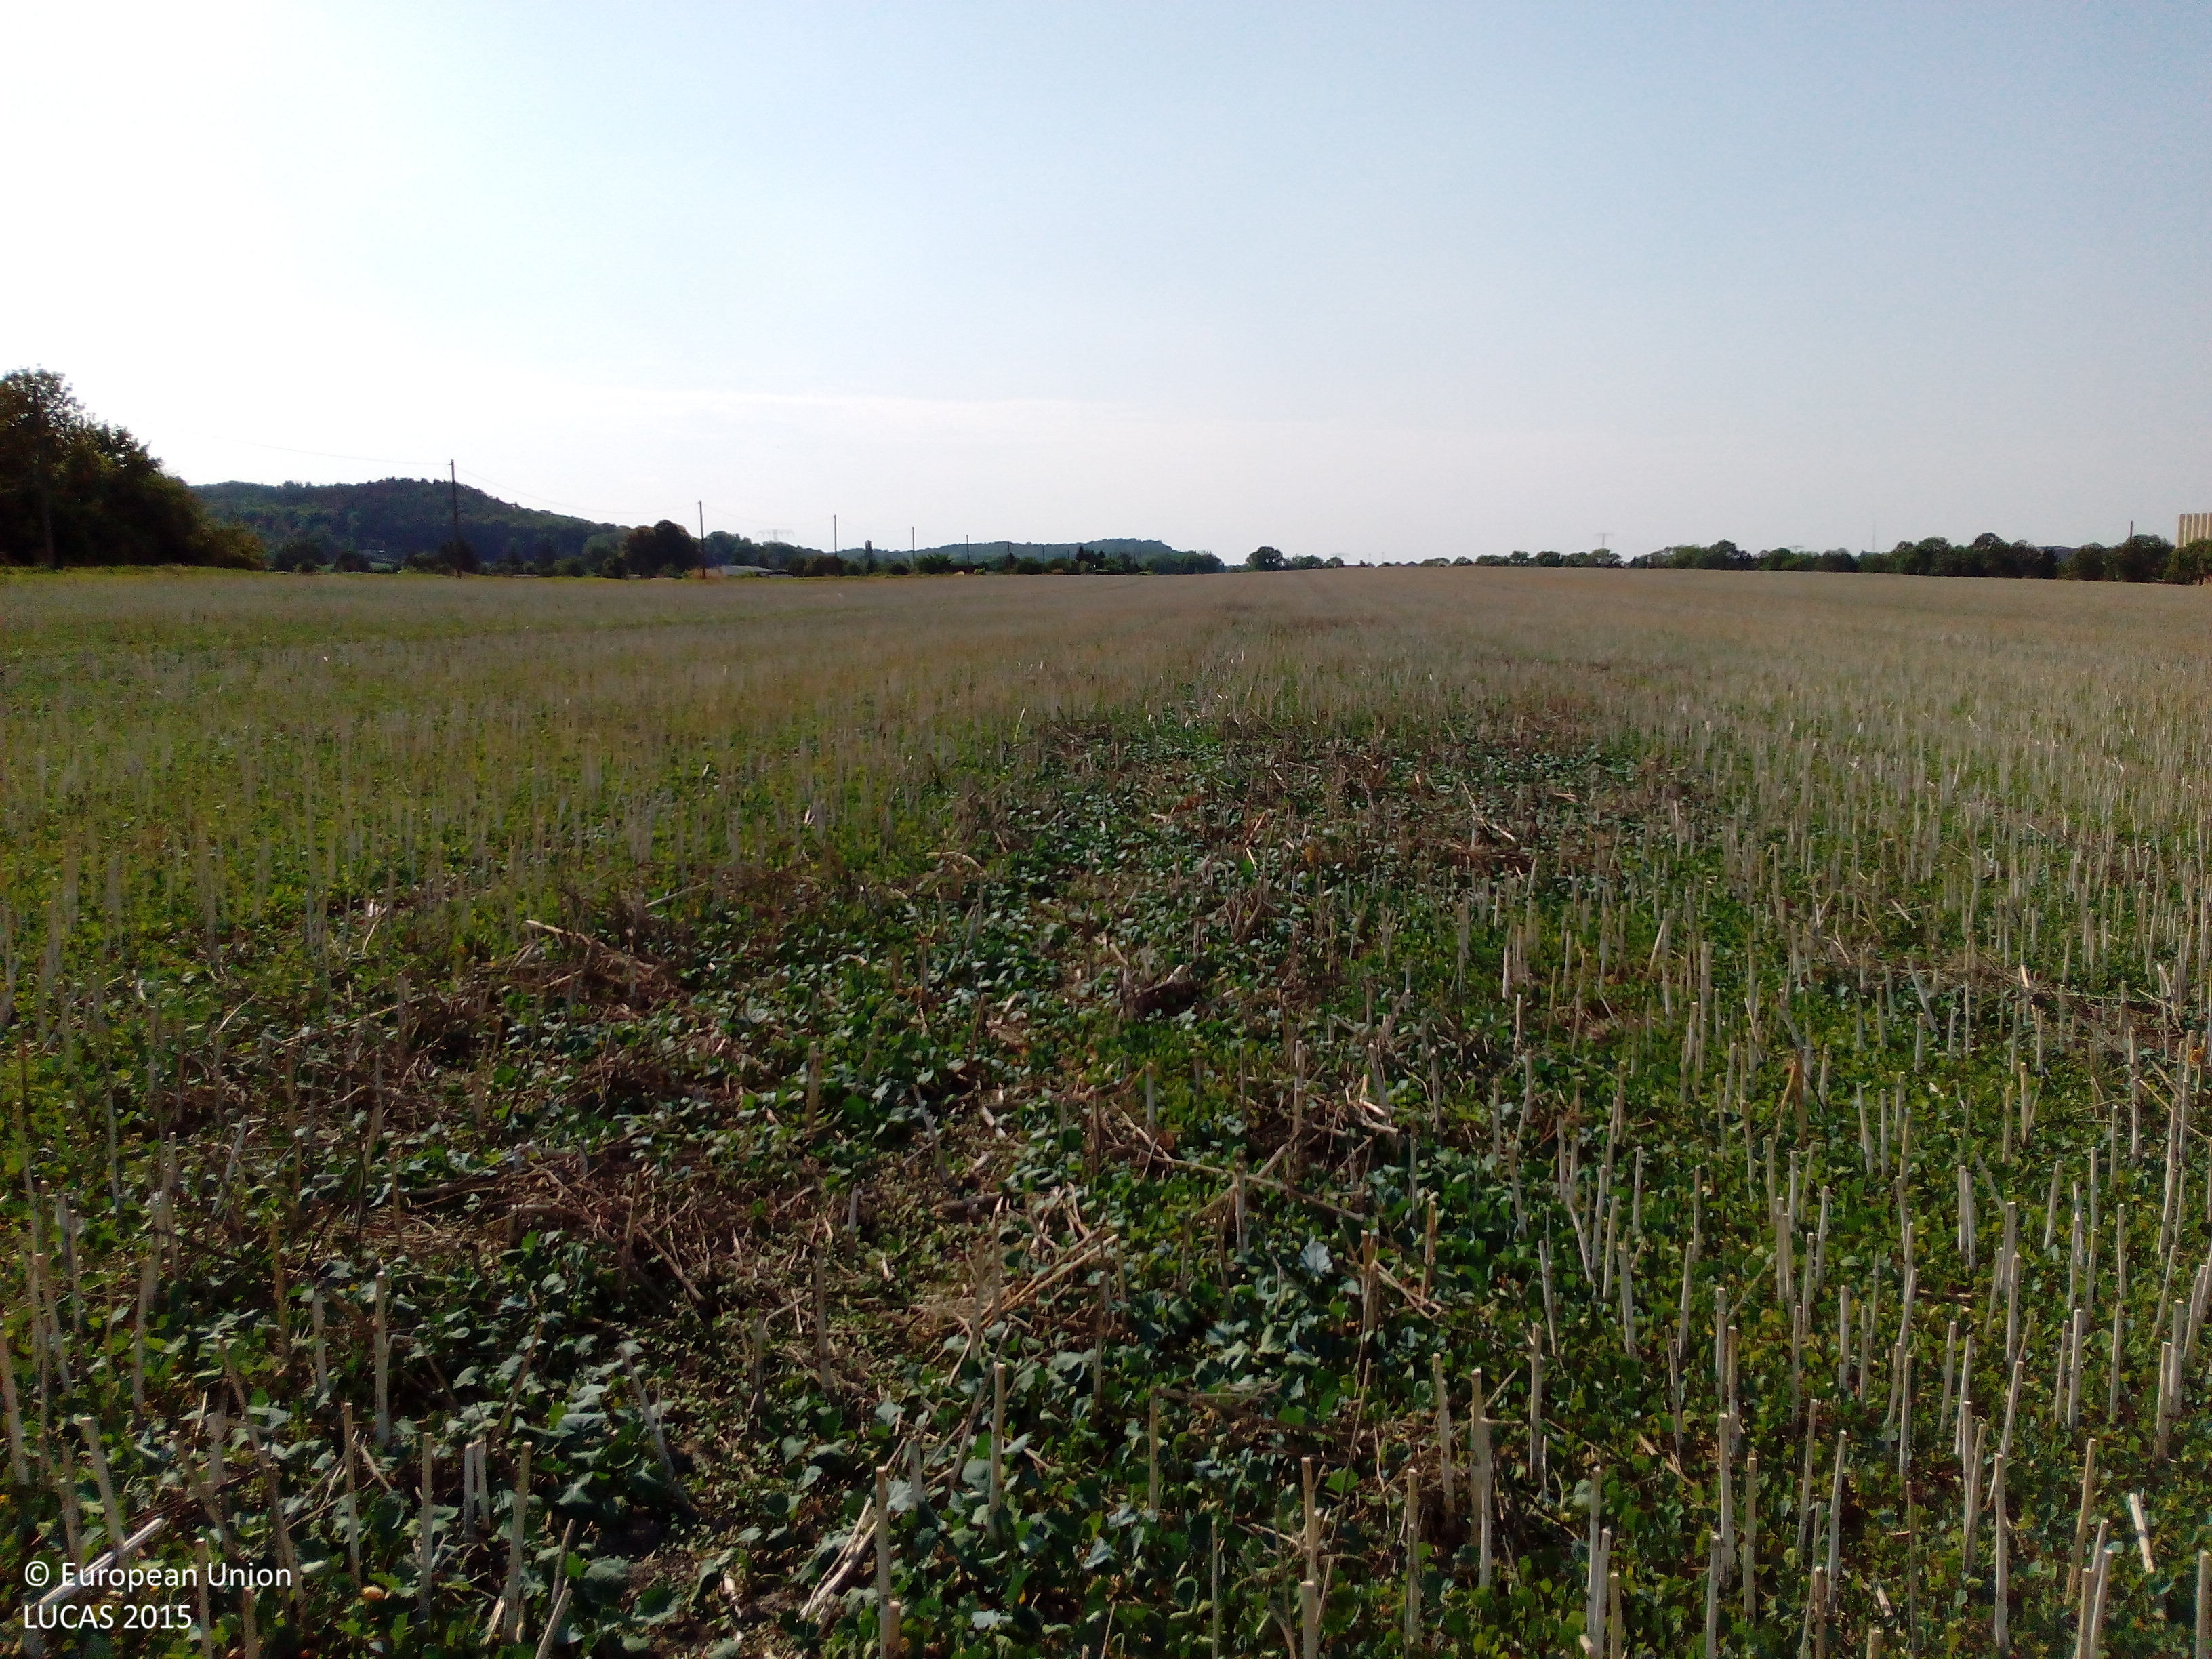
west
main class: Cropland
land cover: Rape and turnip rape
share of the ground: 10 - 25 %
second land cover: Other root crops
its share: 50 - 75 %
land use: Agriculture (excluding fallow land and kitchen gardens)
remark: Harvested field
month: August
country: DE
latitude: 51.8691
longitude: 11.0889
